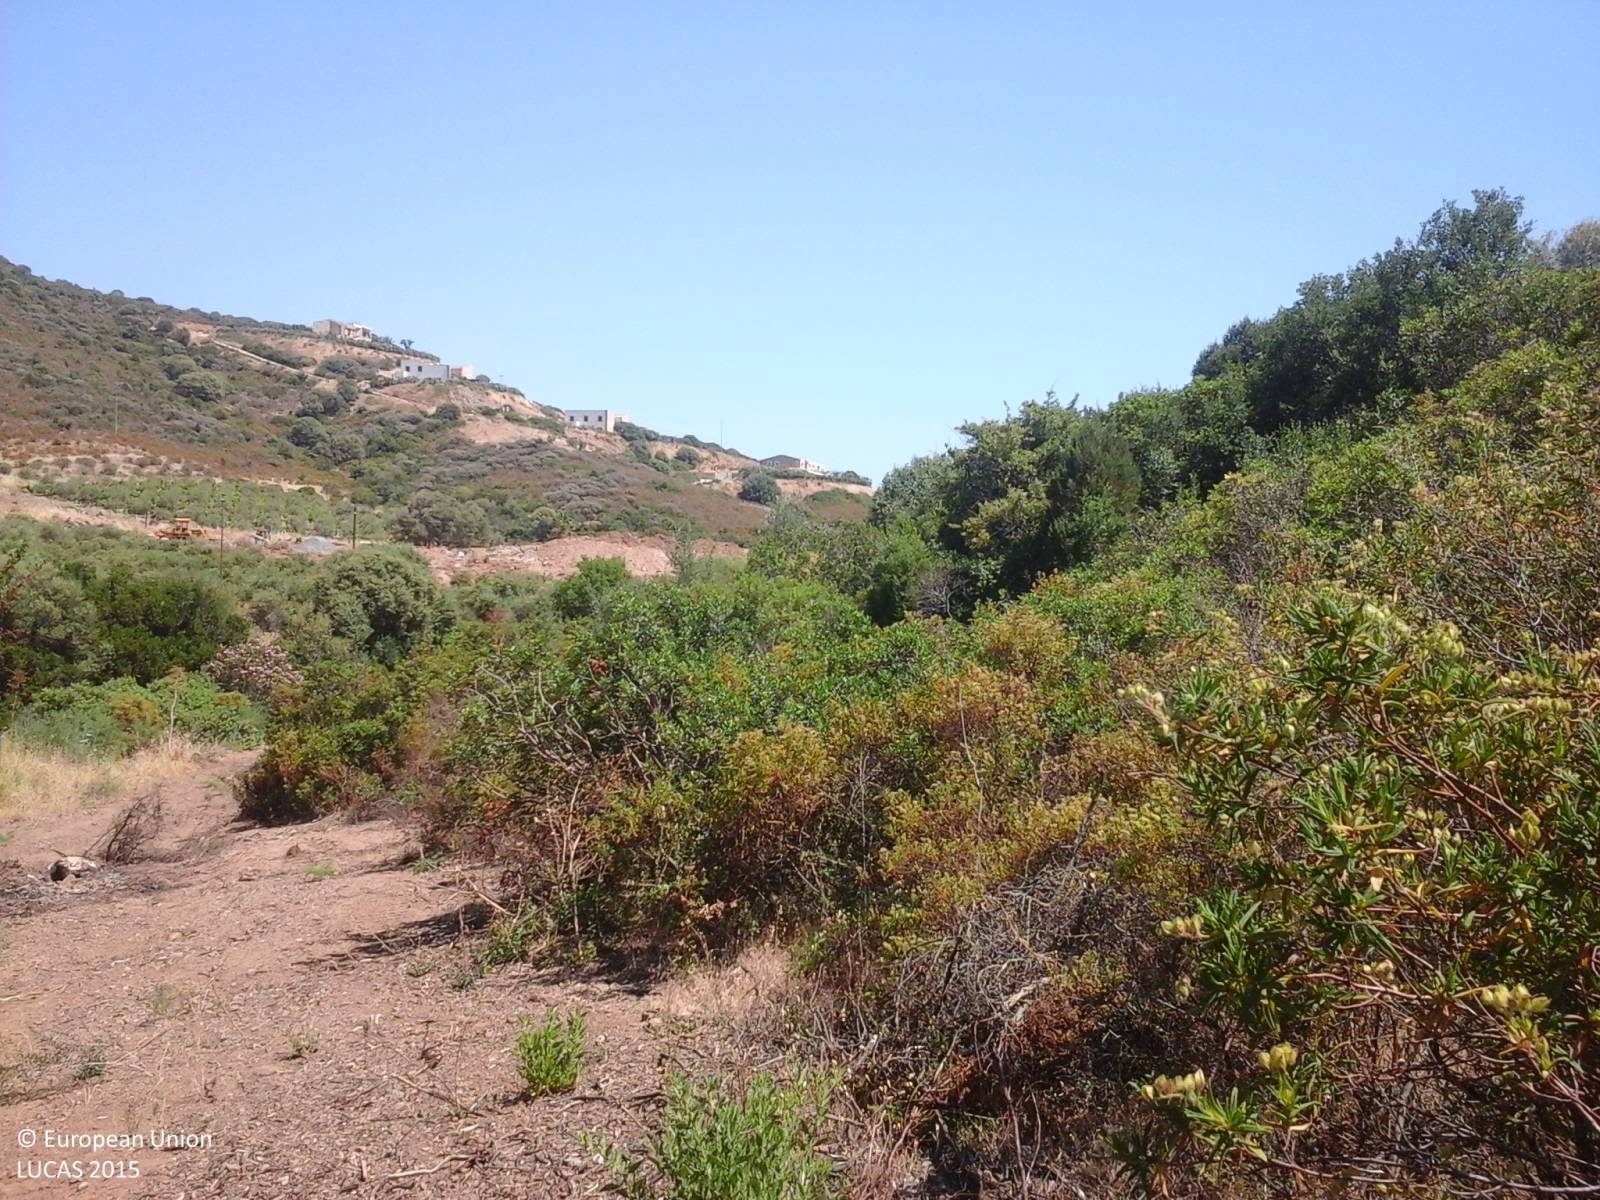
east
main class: Shrubland
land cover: Shrubland with sparse tree cover
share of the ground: 25 - 50 %
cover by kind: shrubs 70 %, herbaceous plants 25 %, broadleaved forest trees 5 %
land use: Agriculture (excluding fallow land and kitchen gardens)
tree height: > 5 m
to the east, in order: Shrubland with sparse tree cover; Tracks; Grassland without tree/shrub cover; Ditches and canals; Grass margins; Abandoned hedges; Grass margins; Paved roads, cycling and walking lanes; Ditches and canals; Fences; Grassland without tree/shrub cover; Fences; Olive groves
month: June
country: IT
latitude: 38.9201
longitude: 8.8655
